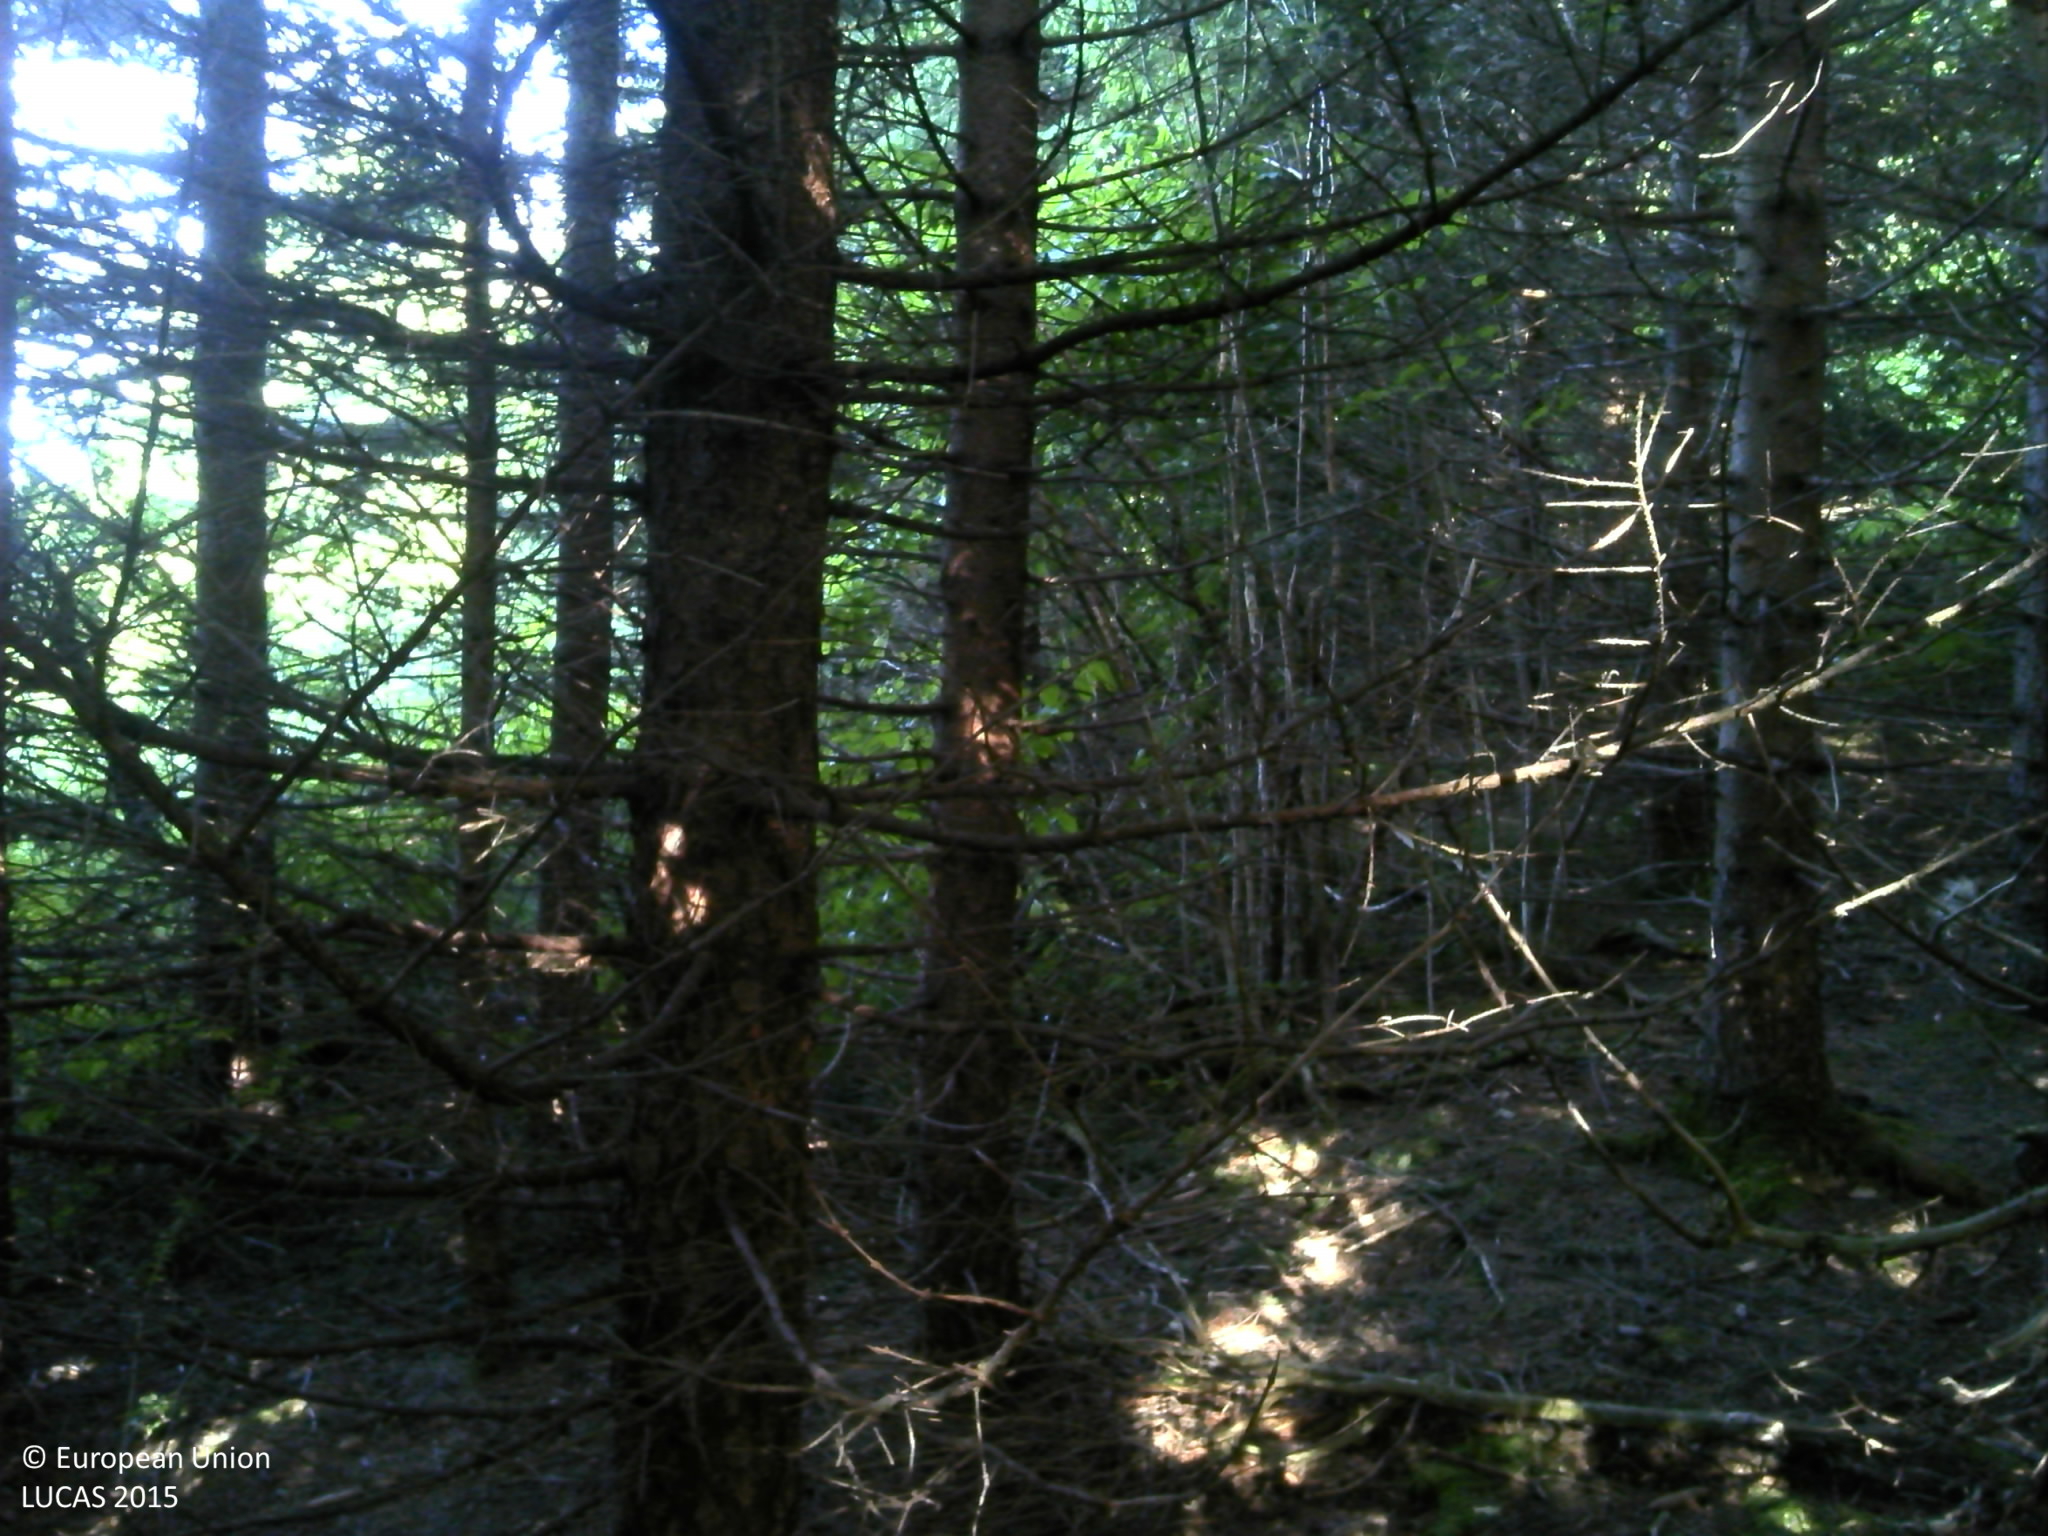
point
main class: Woodland
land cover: Spruce dominated mixed woodland
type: hemiboreal forest and nemoral coniferous forest and mixed broadleaved-coniferous forest
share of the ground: > 75 %
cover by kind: coniferous forest trees 75 %, broadleaved forest trees 25 %
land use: Semi-natural and natural areas not in use
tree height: > 5 m
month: June
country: HR
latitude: 44.7754
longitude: 15.6429
